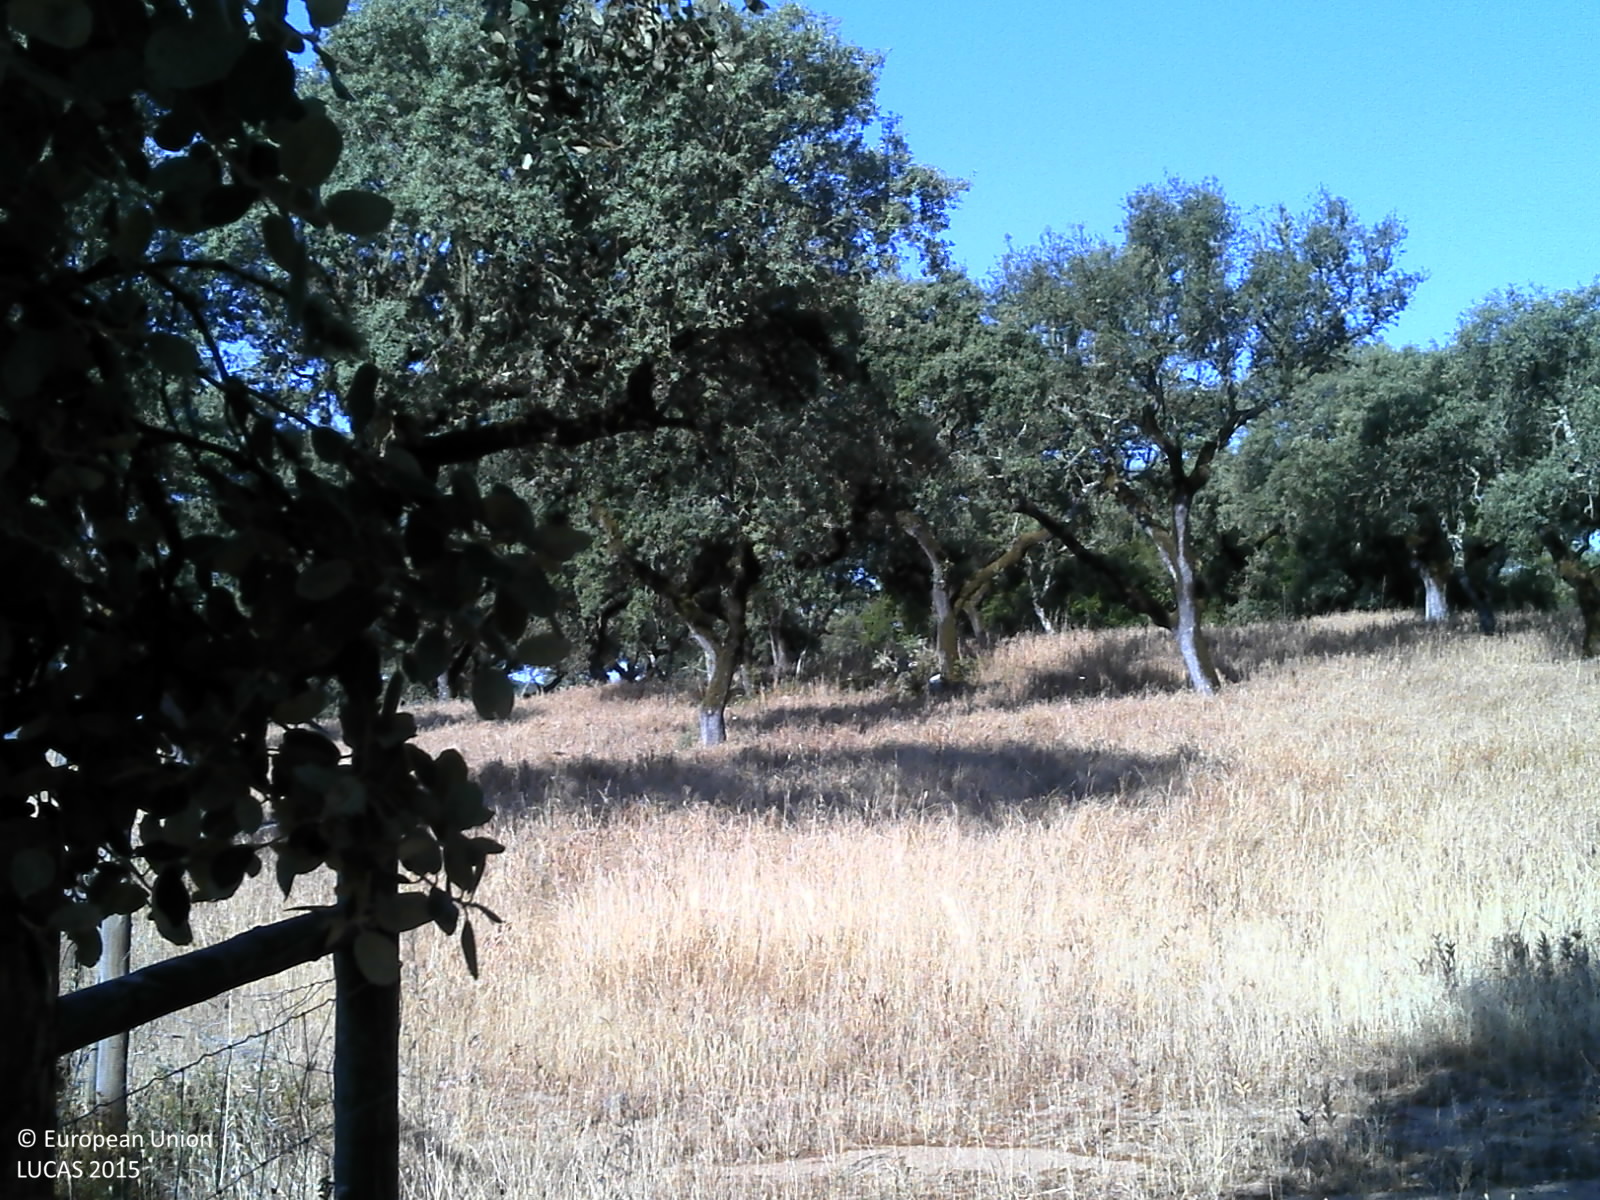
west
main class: Woodland
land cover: Broadleaved woodland
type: broadleaved evergreen forest
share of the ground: > 75 %
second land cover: Other leguminous and mixtures for fodder
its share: > 75 %
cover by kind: broadleaved forest trees 75 %, herbaceous plants 25 %
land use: Forestry
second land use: Agriculture (excluding fallow land and kitchen gardens)
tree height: > 5 m
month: June
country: PT
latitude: 38.6647
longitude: -8.0774
